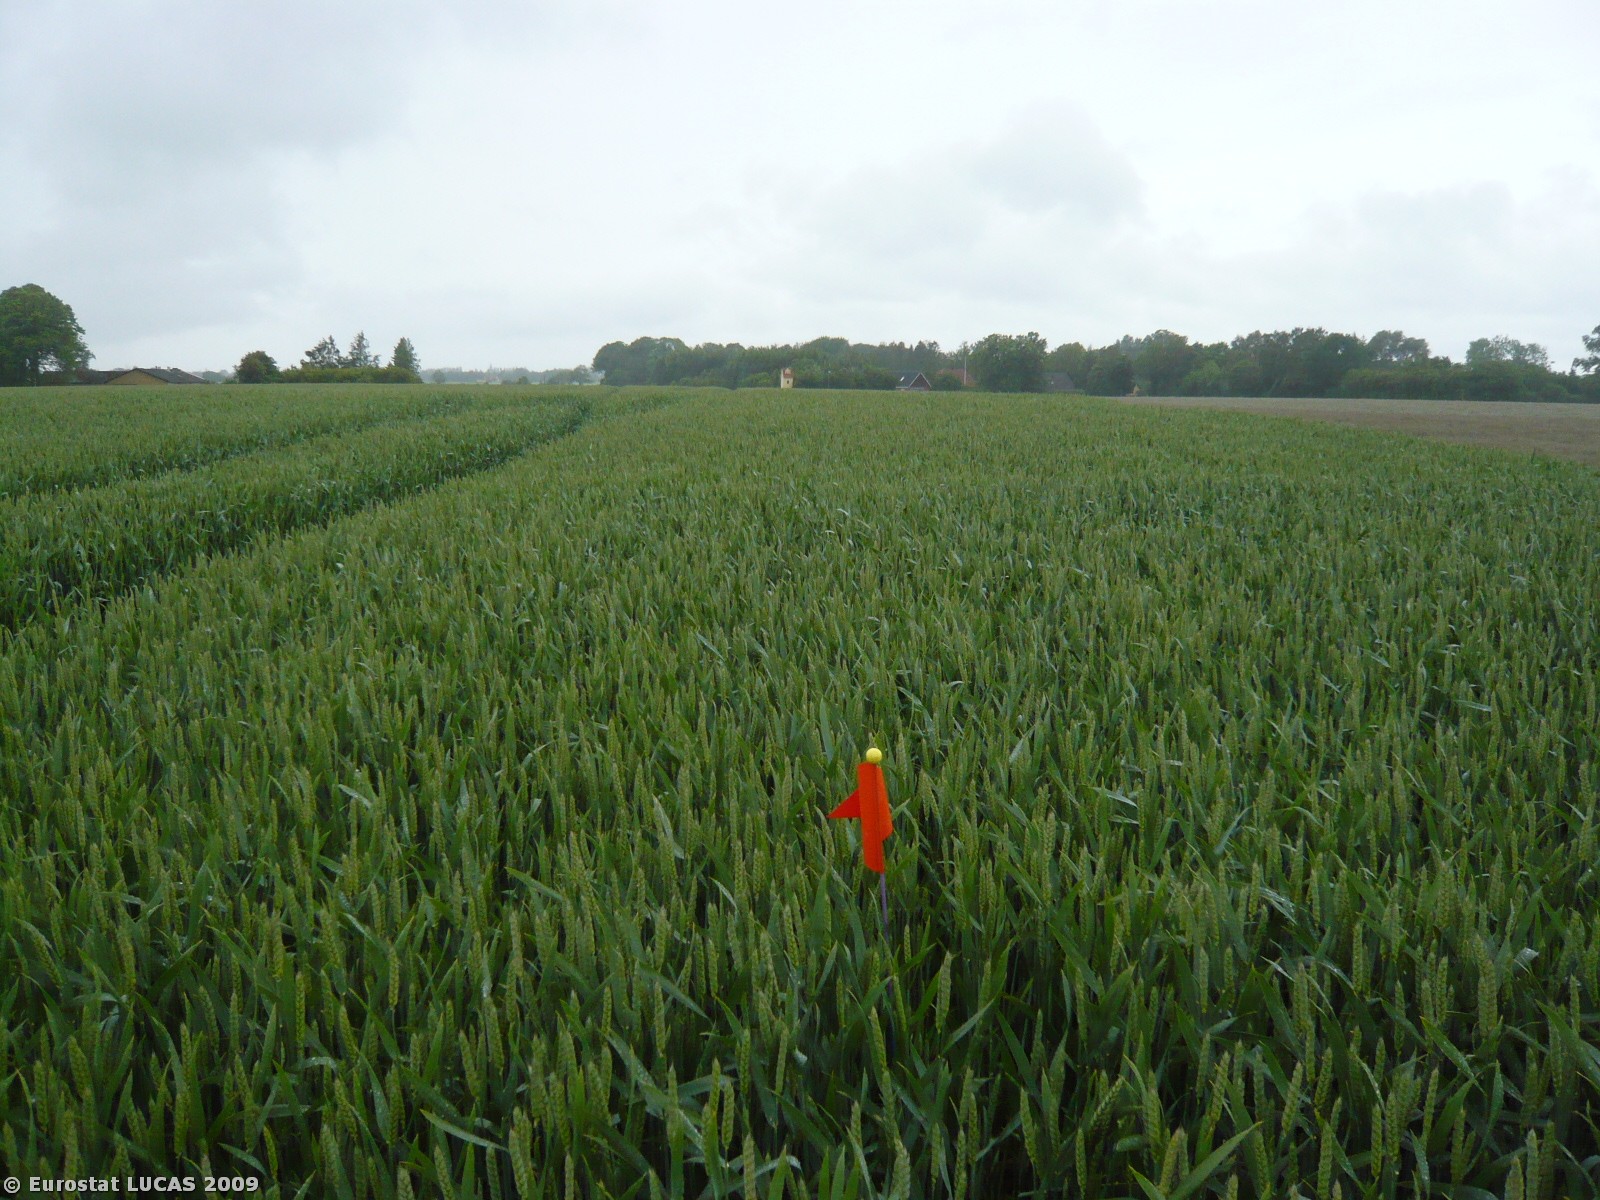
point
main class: Cropland
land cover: Common wheat
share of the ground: > 75 %
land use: Agriculture (excluding fallow land and kitchen gardens)
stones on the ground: 10 - 25 %
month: June
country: DK
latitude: 54.7882
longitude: 11.9738
